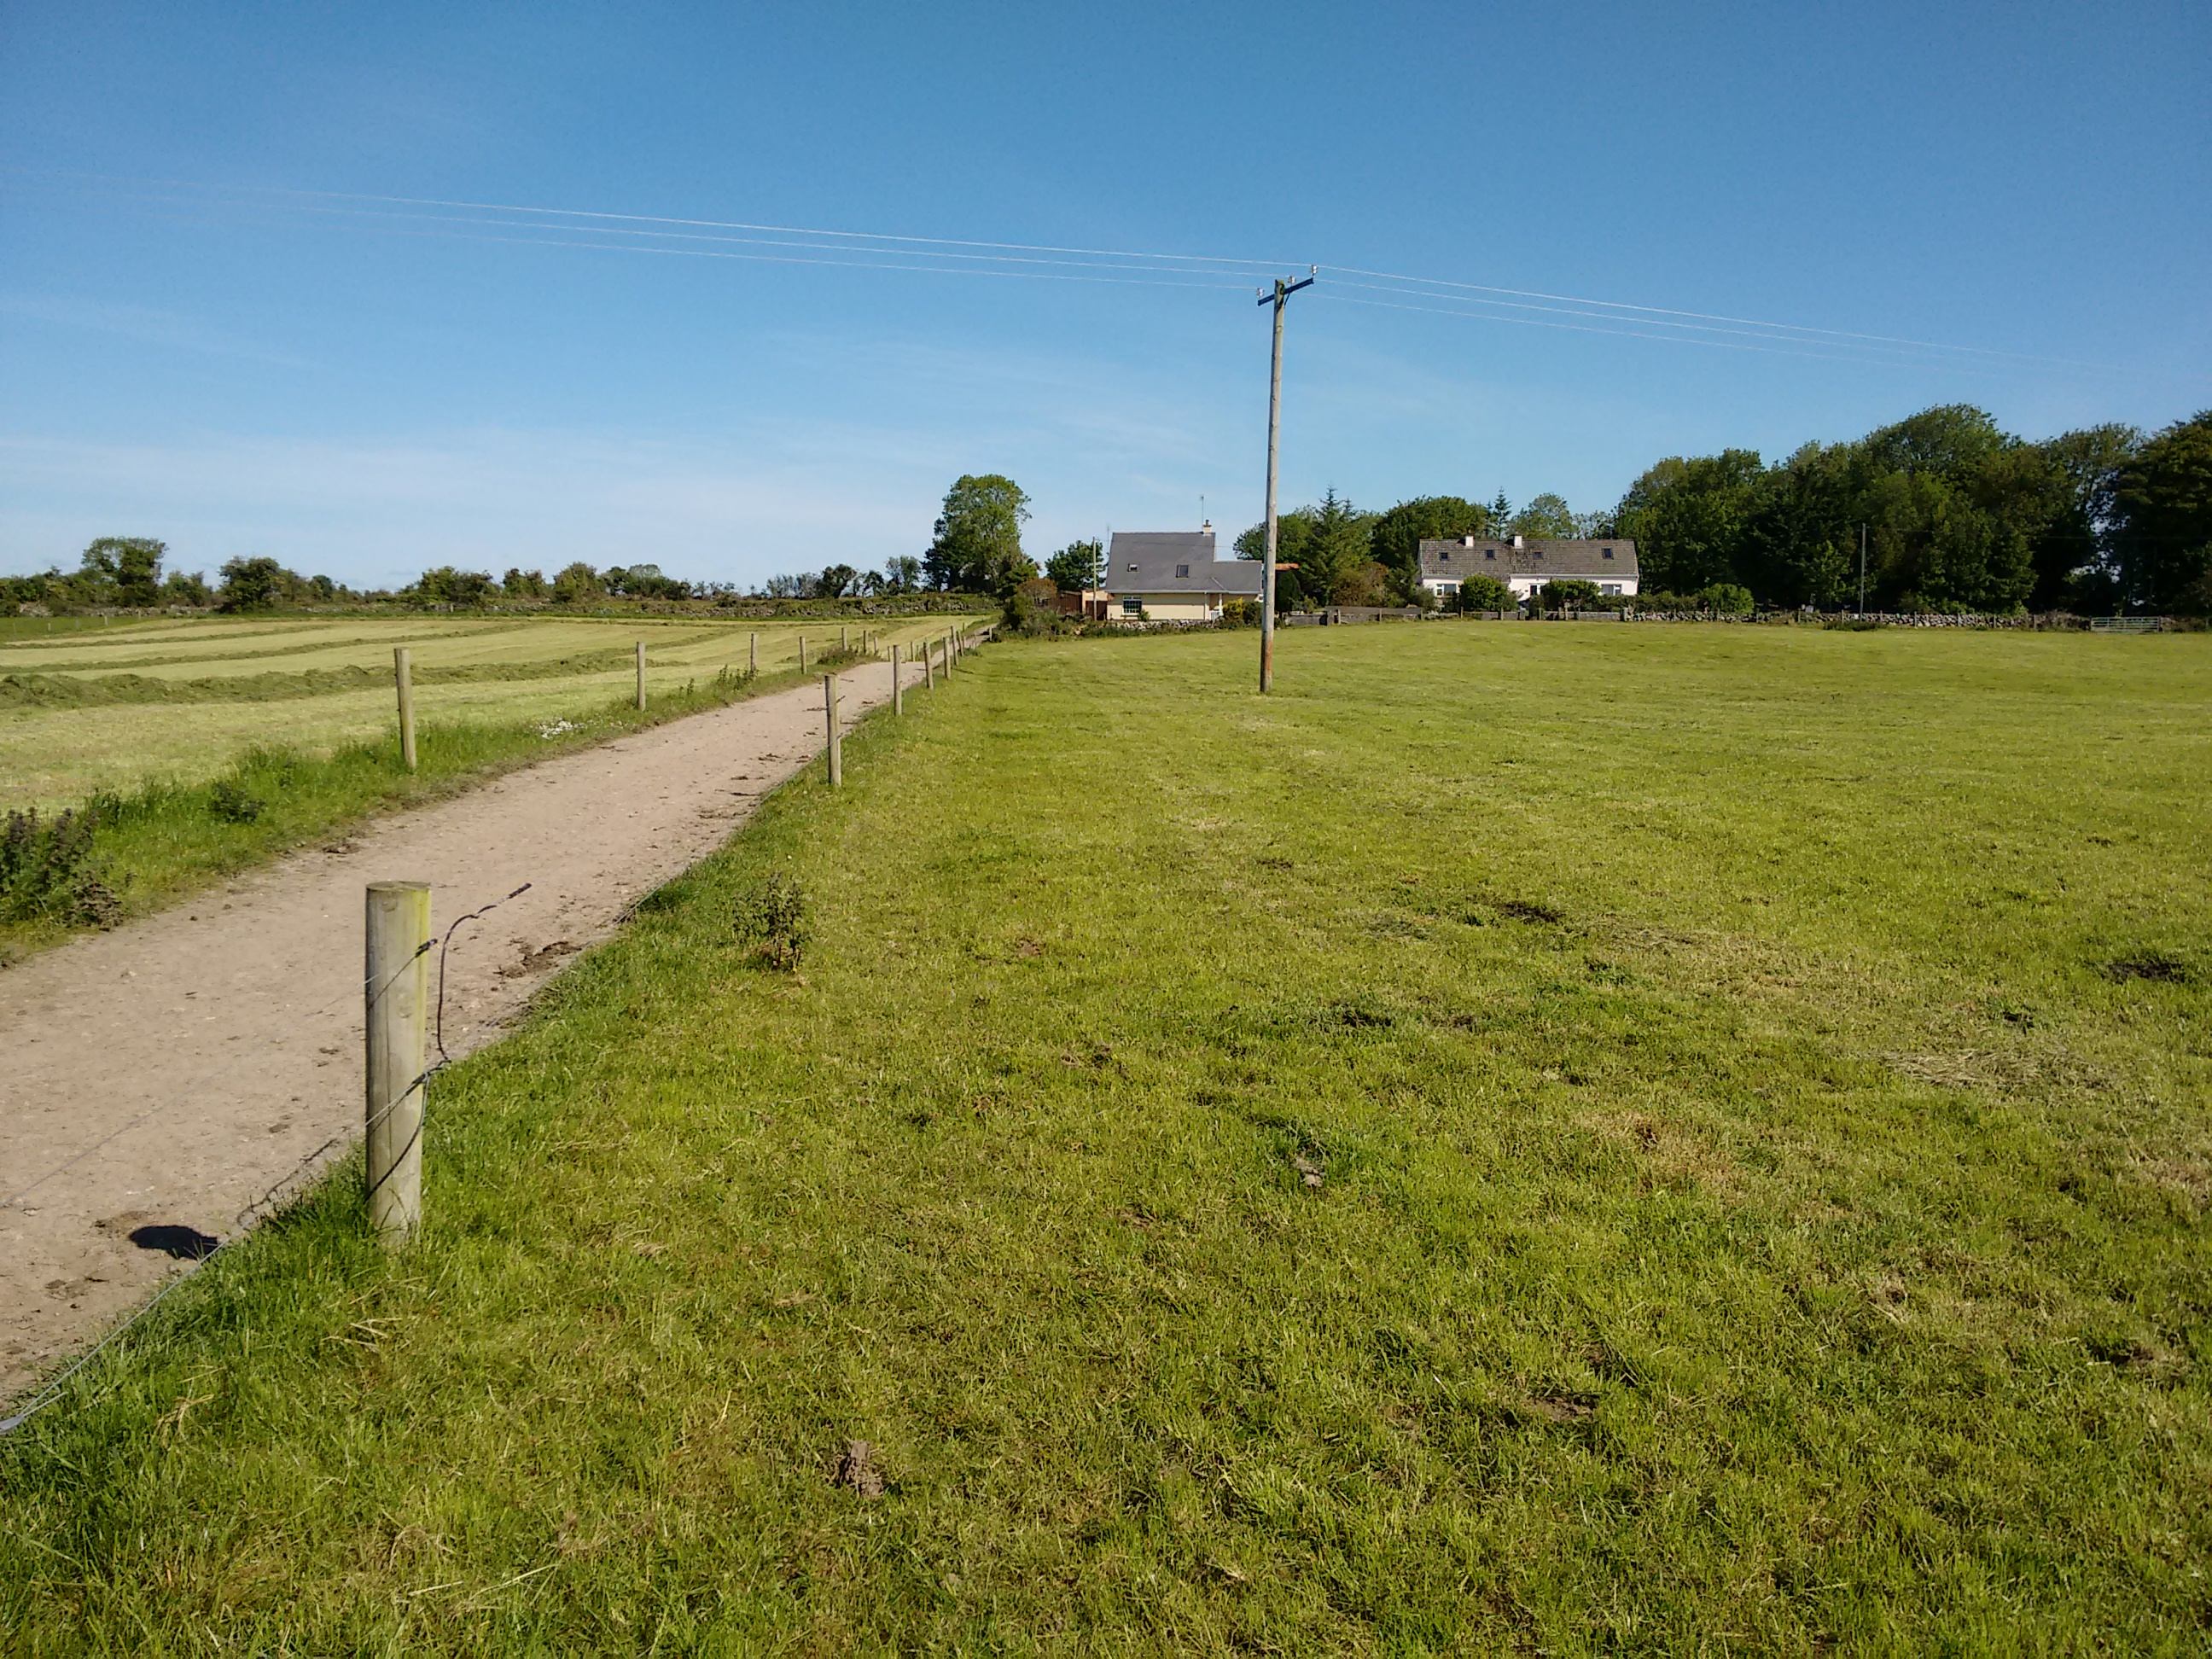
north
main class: Grassland
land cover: Grassland without tree/shrub cover
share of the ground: > 75 %
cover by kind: herbaceous plants 100 %
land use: Agriculture (excluding fallow land and kitchen gardens)
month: June
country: IE
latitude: 53.1902
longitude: -8.6530
